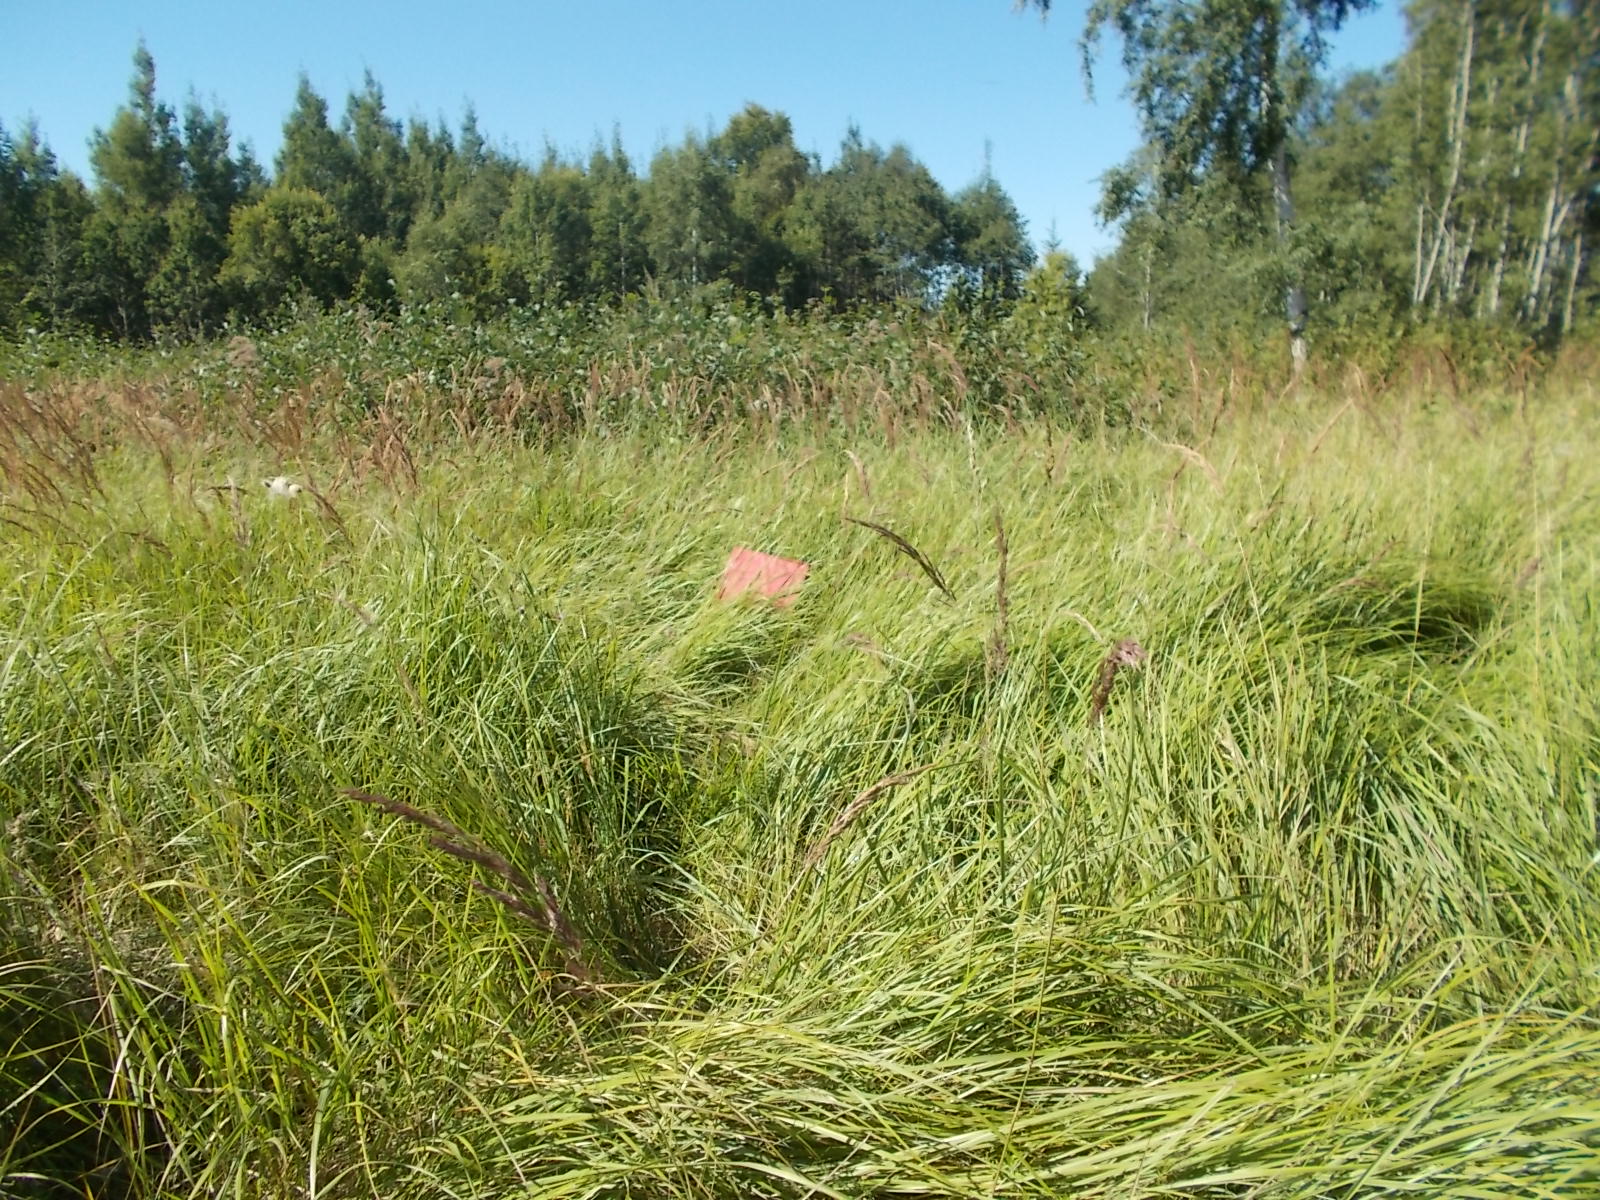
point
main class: Grassland
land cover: Spontaneously vegetated surfaces
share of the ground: > 75 %
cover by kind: herbaceous plants 95 %, shrubs 5 %
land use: Semi-natural and natural areas not in use
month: August
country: LV
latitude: 56.8815
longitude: 22.9121
